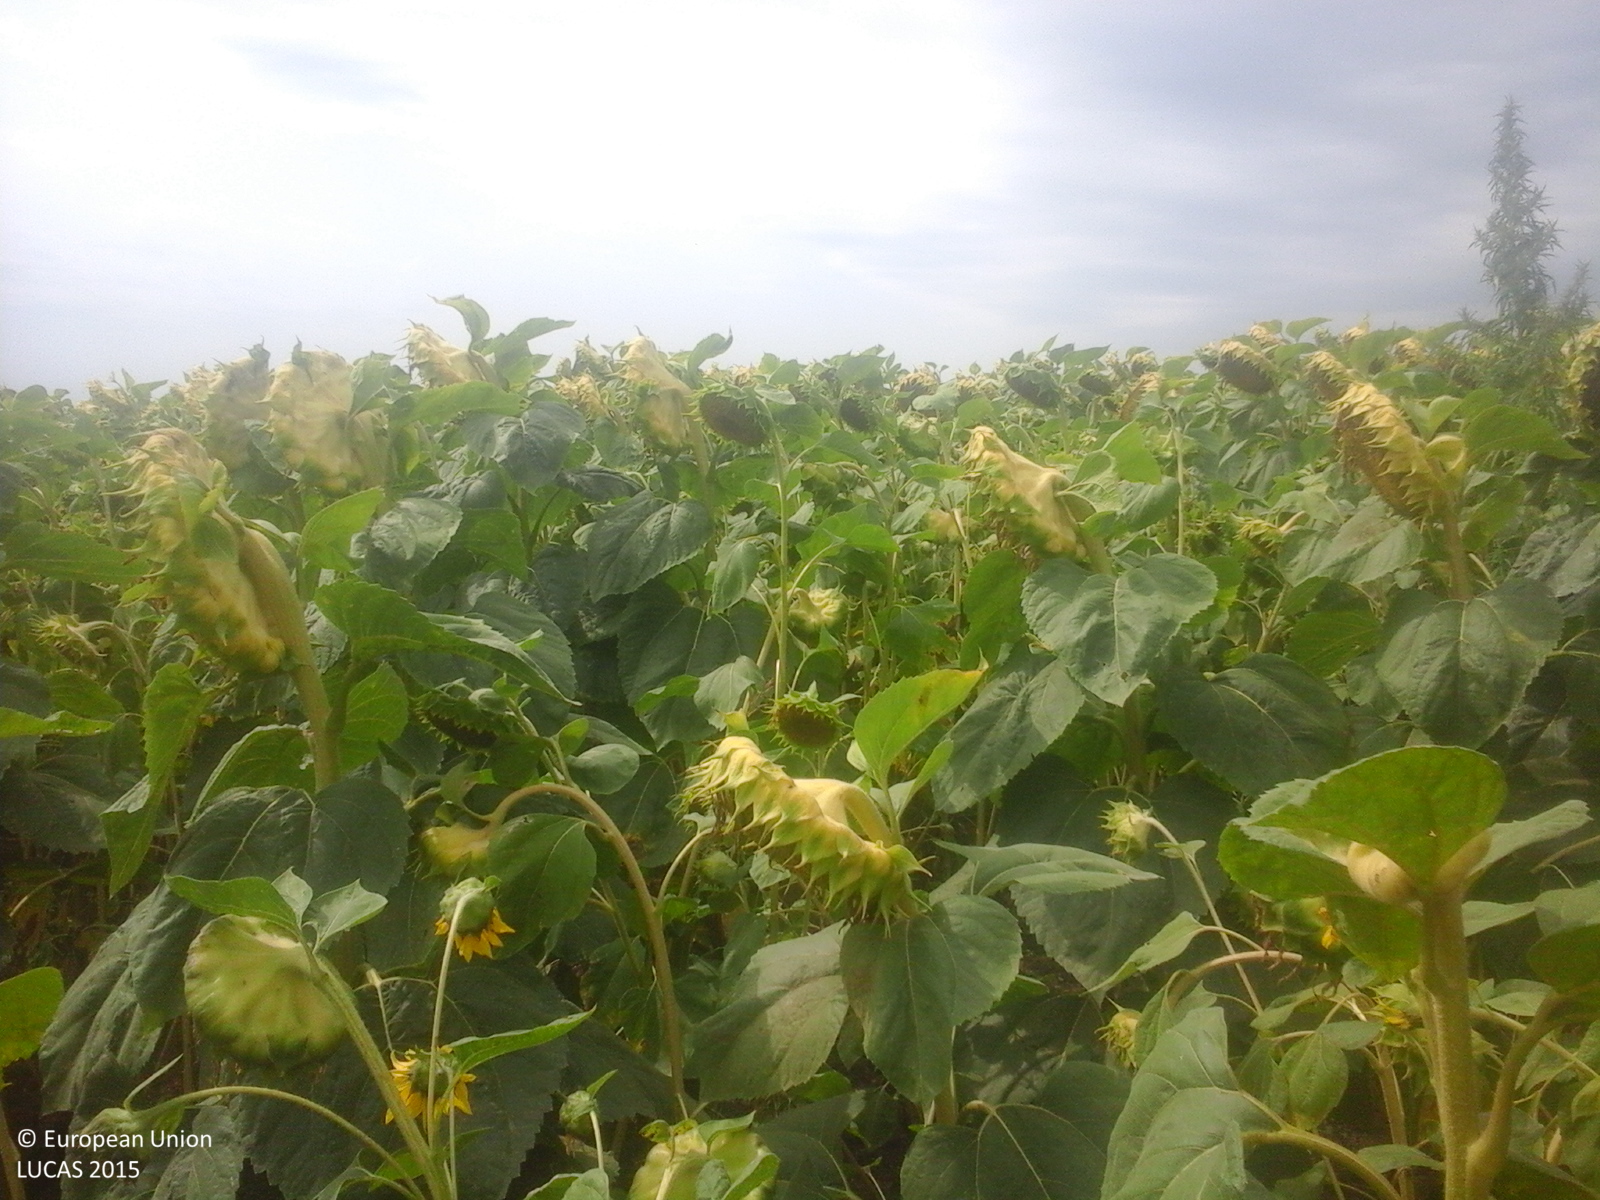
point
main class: Cropland
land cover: Sunflower
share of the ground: > 75 %
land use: Agriculture (excluding fallow land and kitchen gardens)
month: August
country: RO
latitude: 43.9231
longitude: 28.2042
